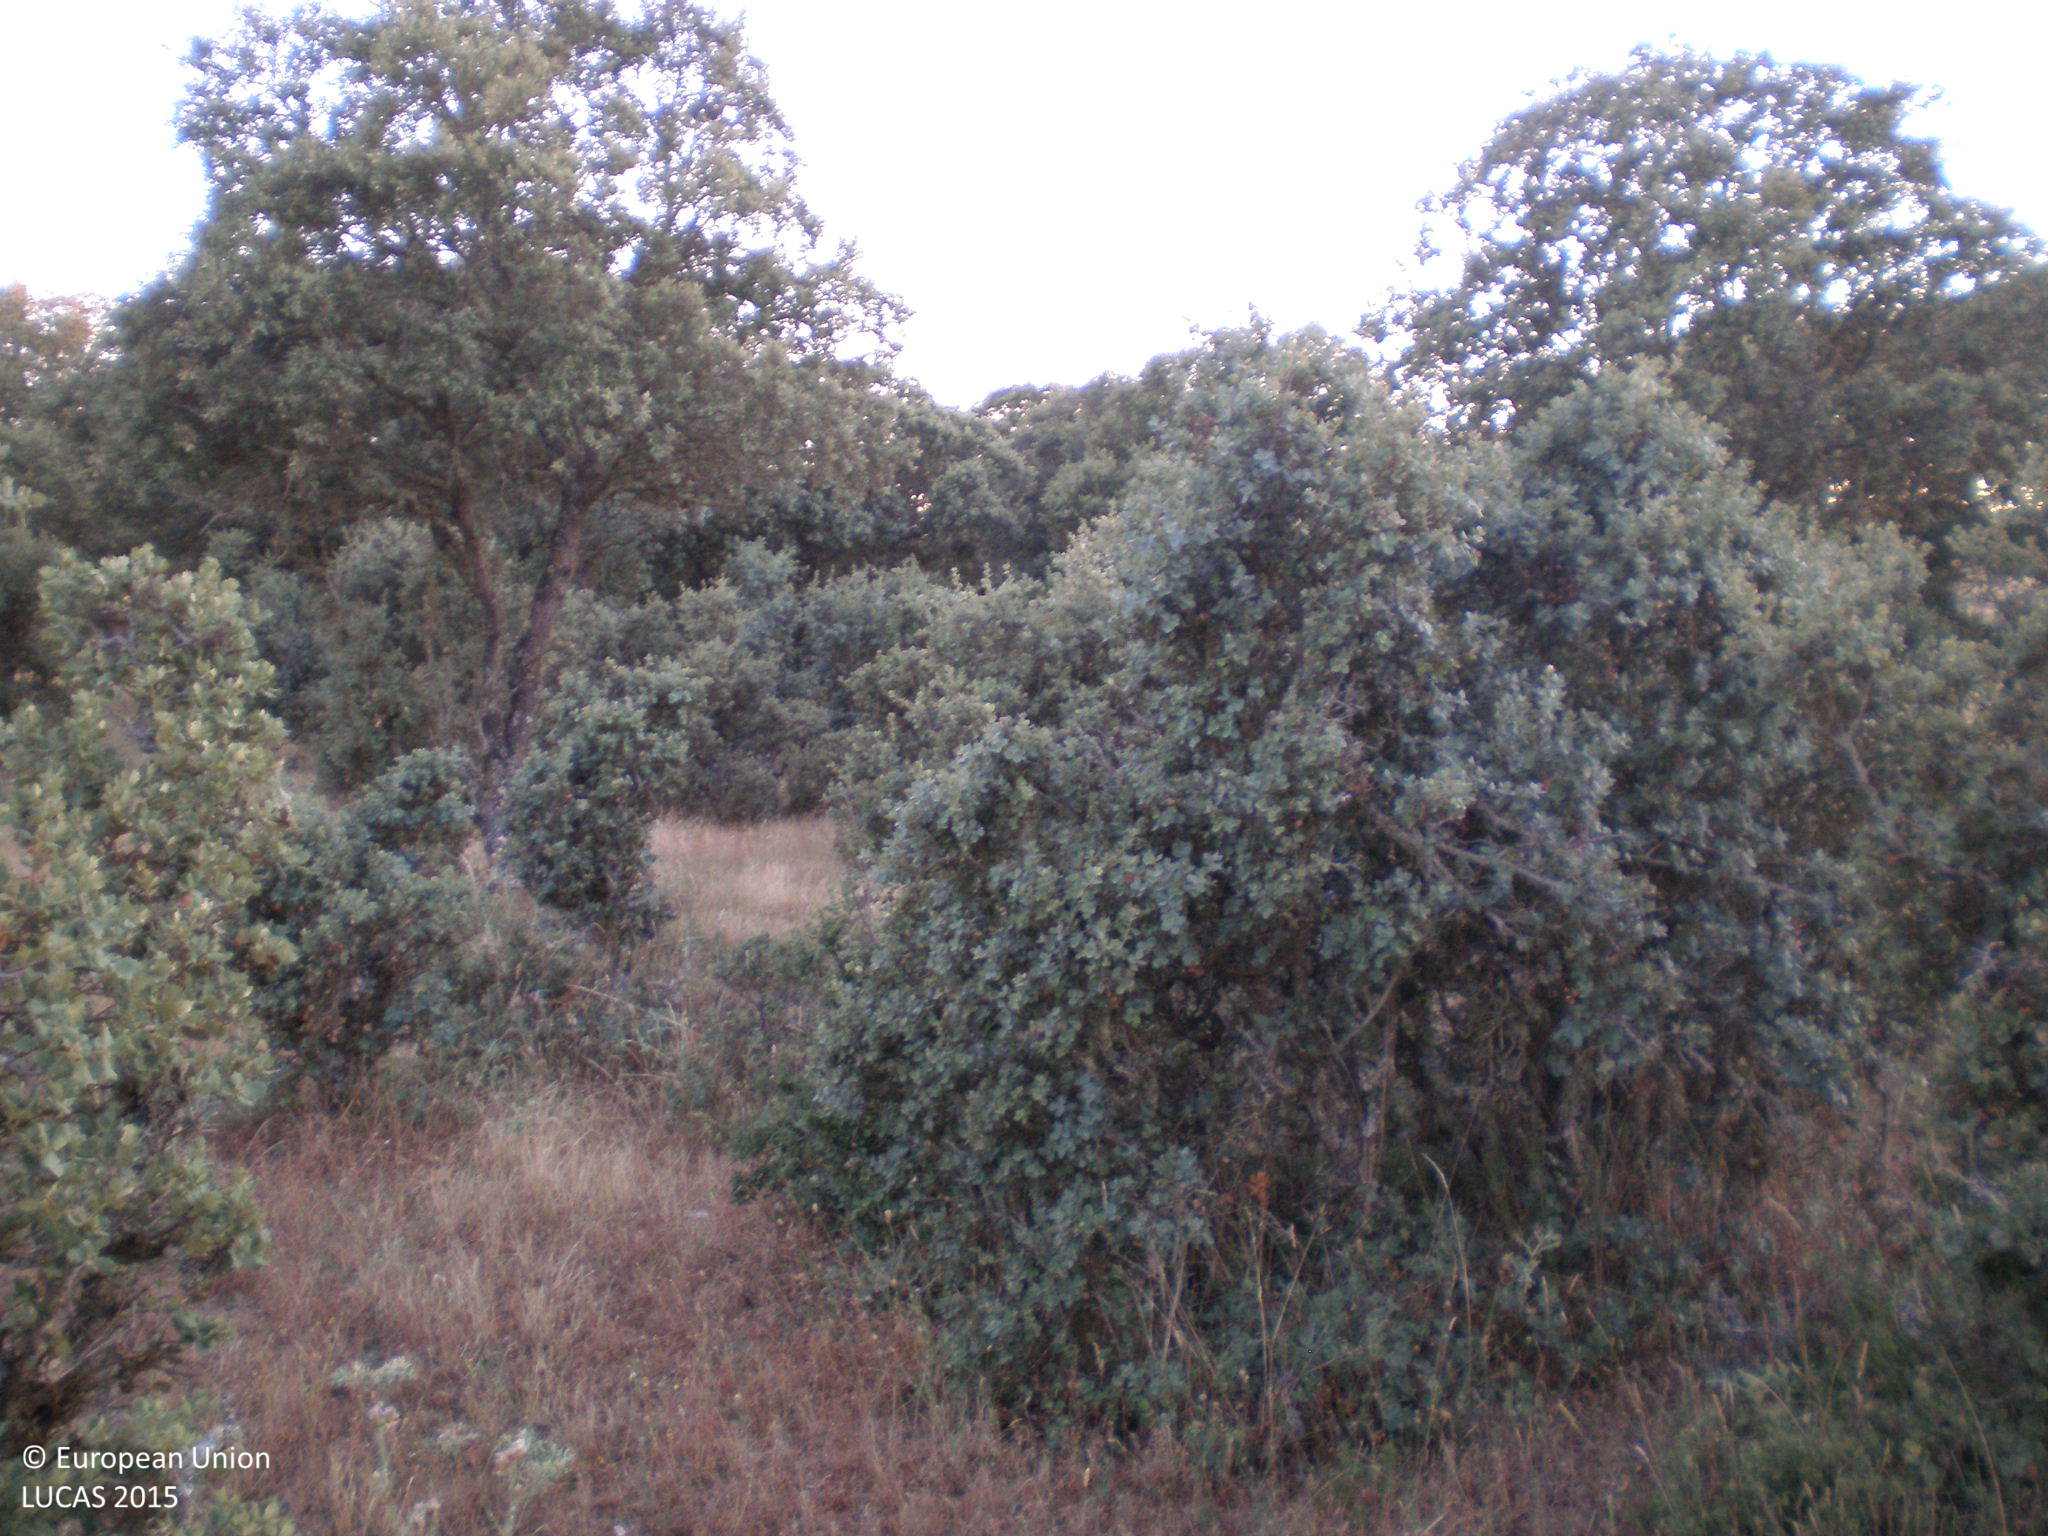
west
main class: Woodland
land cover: Broadleaved woodland
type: broadleaved evergreen forest
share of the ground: 25 - 50 %
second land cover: Grassland without tree/shrub cover
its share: 50 - 75 %
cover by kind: herbaceous plants 70 %, broadleaved forest trees 30 %
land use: Forestry
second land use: Agriculture (excluding fallow land and kitchen gardens)
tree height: < 5 m
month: June
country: ES
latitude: 40.6536
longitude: -5.6724
